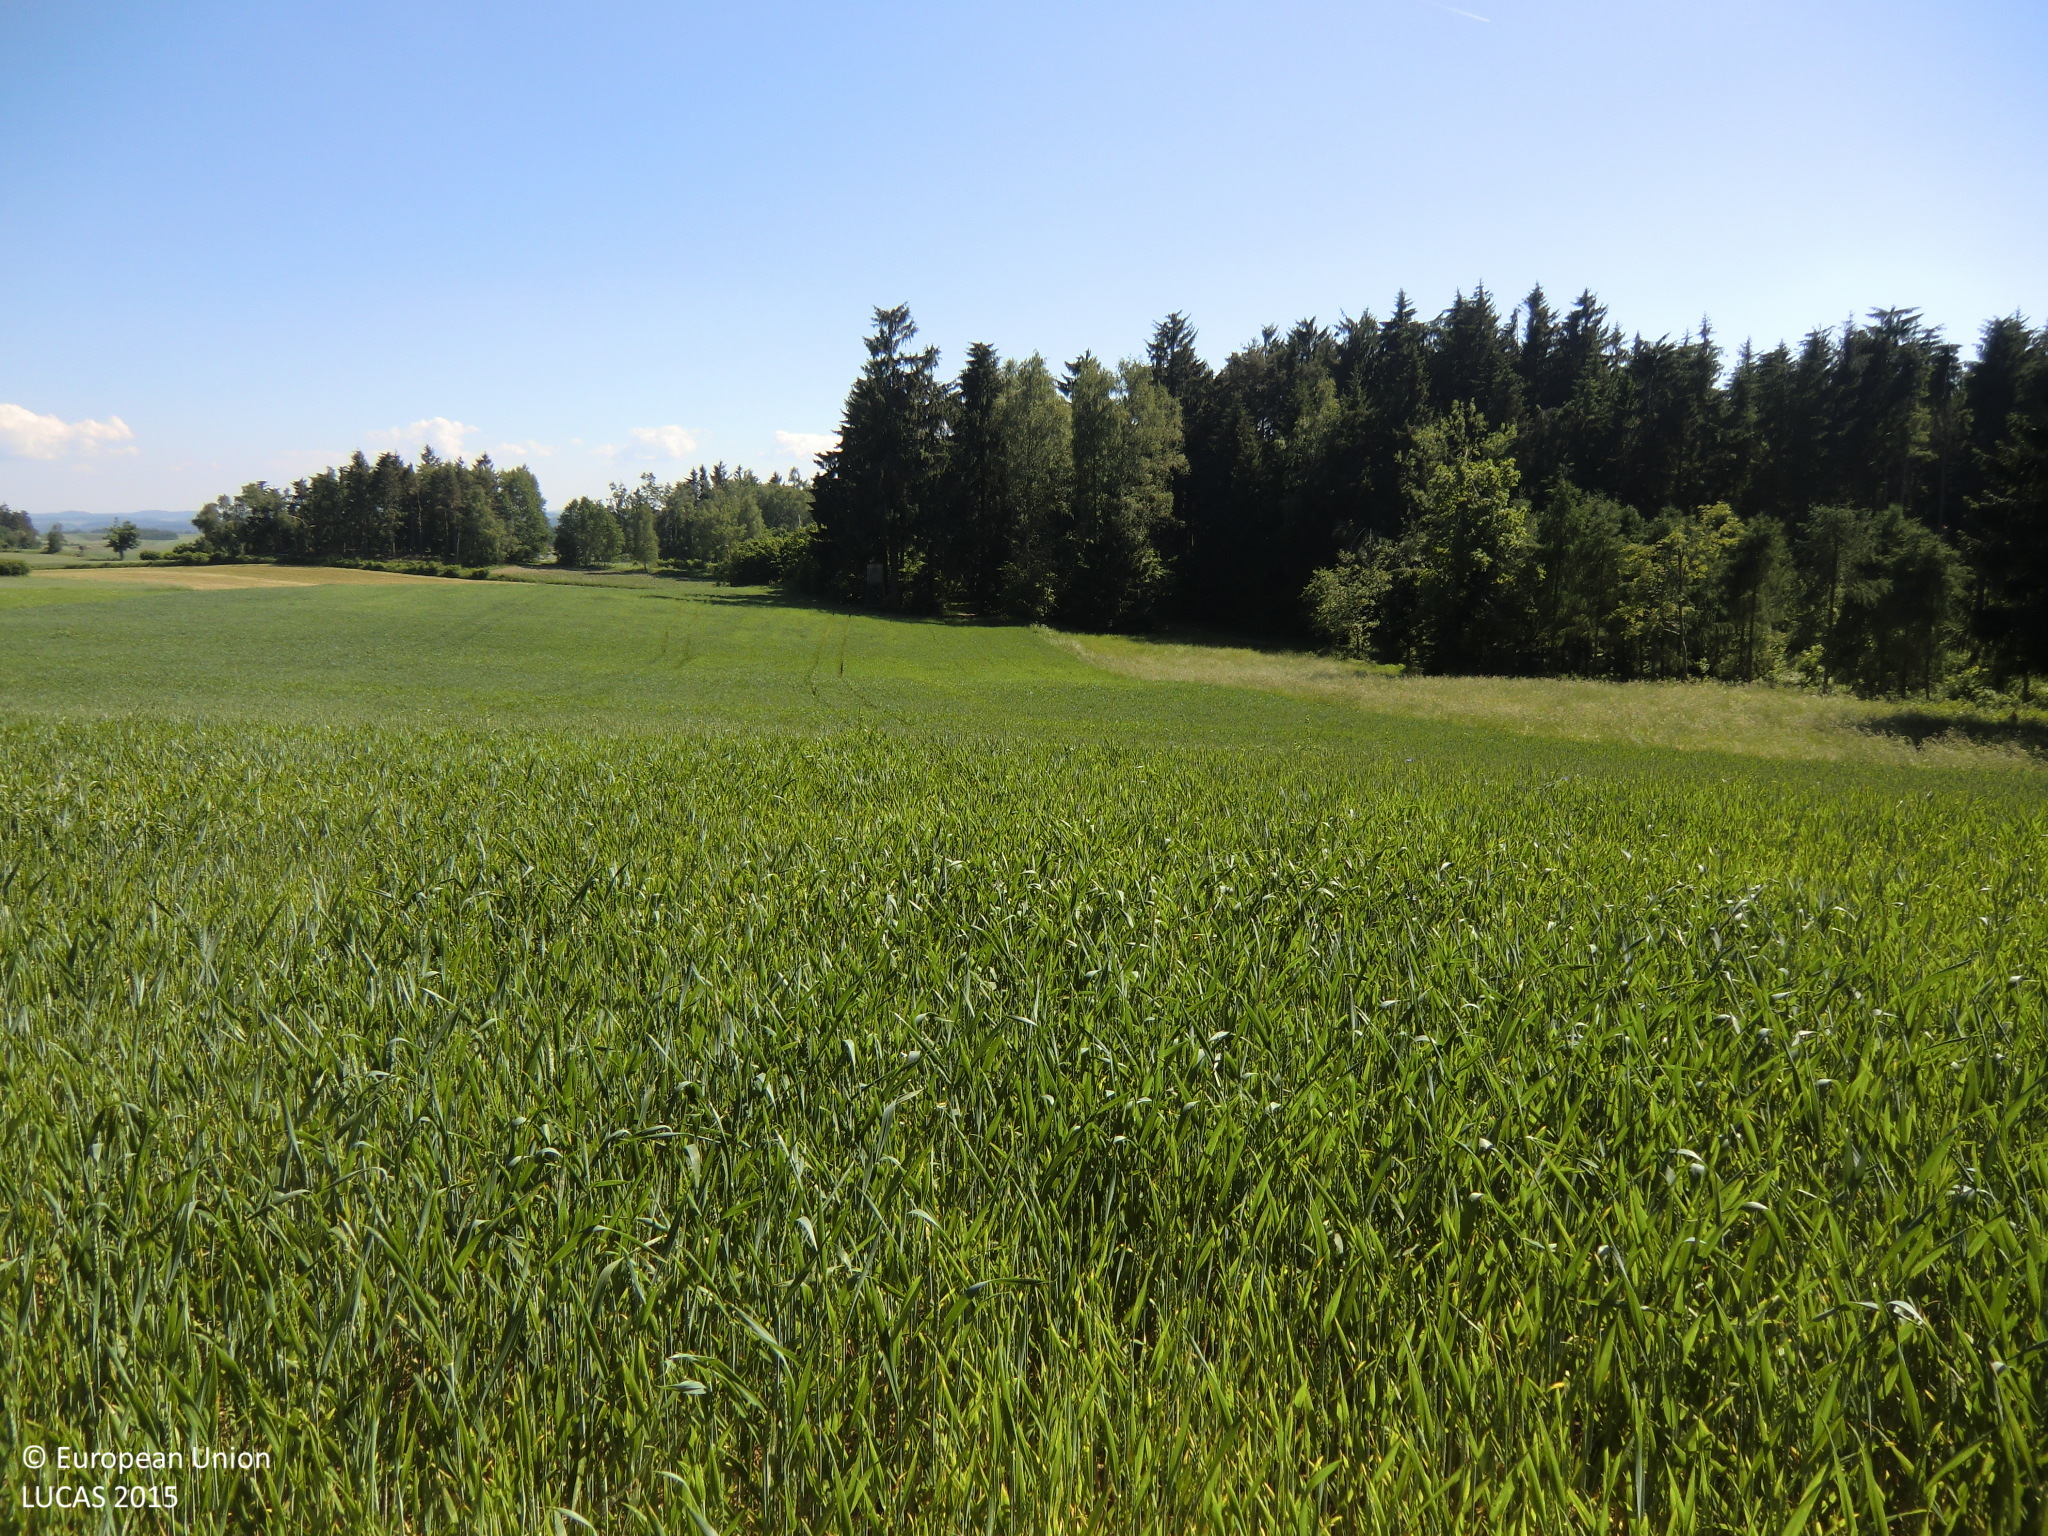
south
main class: Cropland
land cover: Common wheat
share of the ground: > 75 %
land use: Agriculture (excluding fallow land and kitchen gardens)
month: June
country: AT
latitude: 48.6851
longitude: 15.0413
